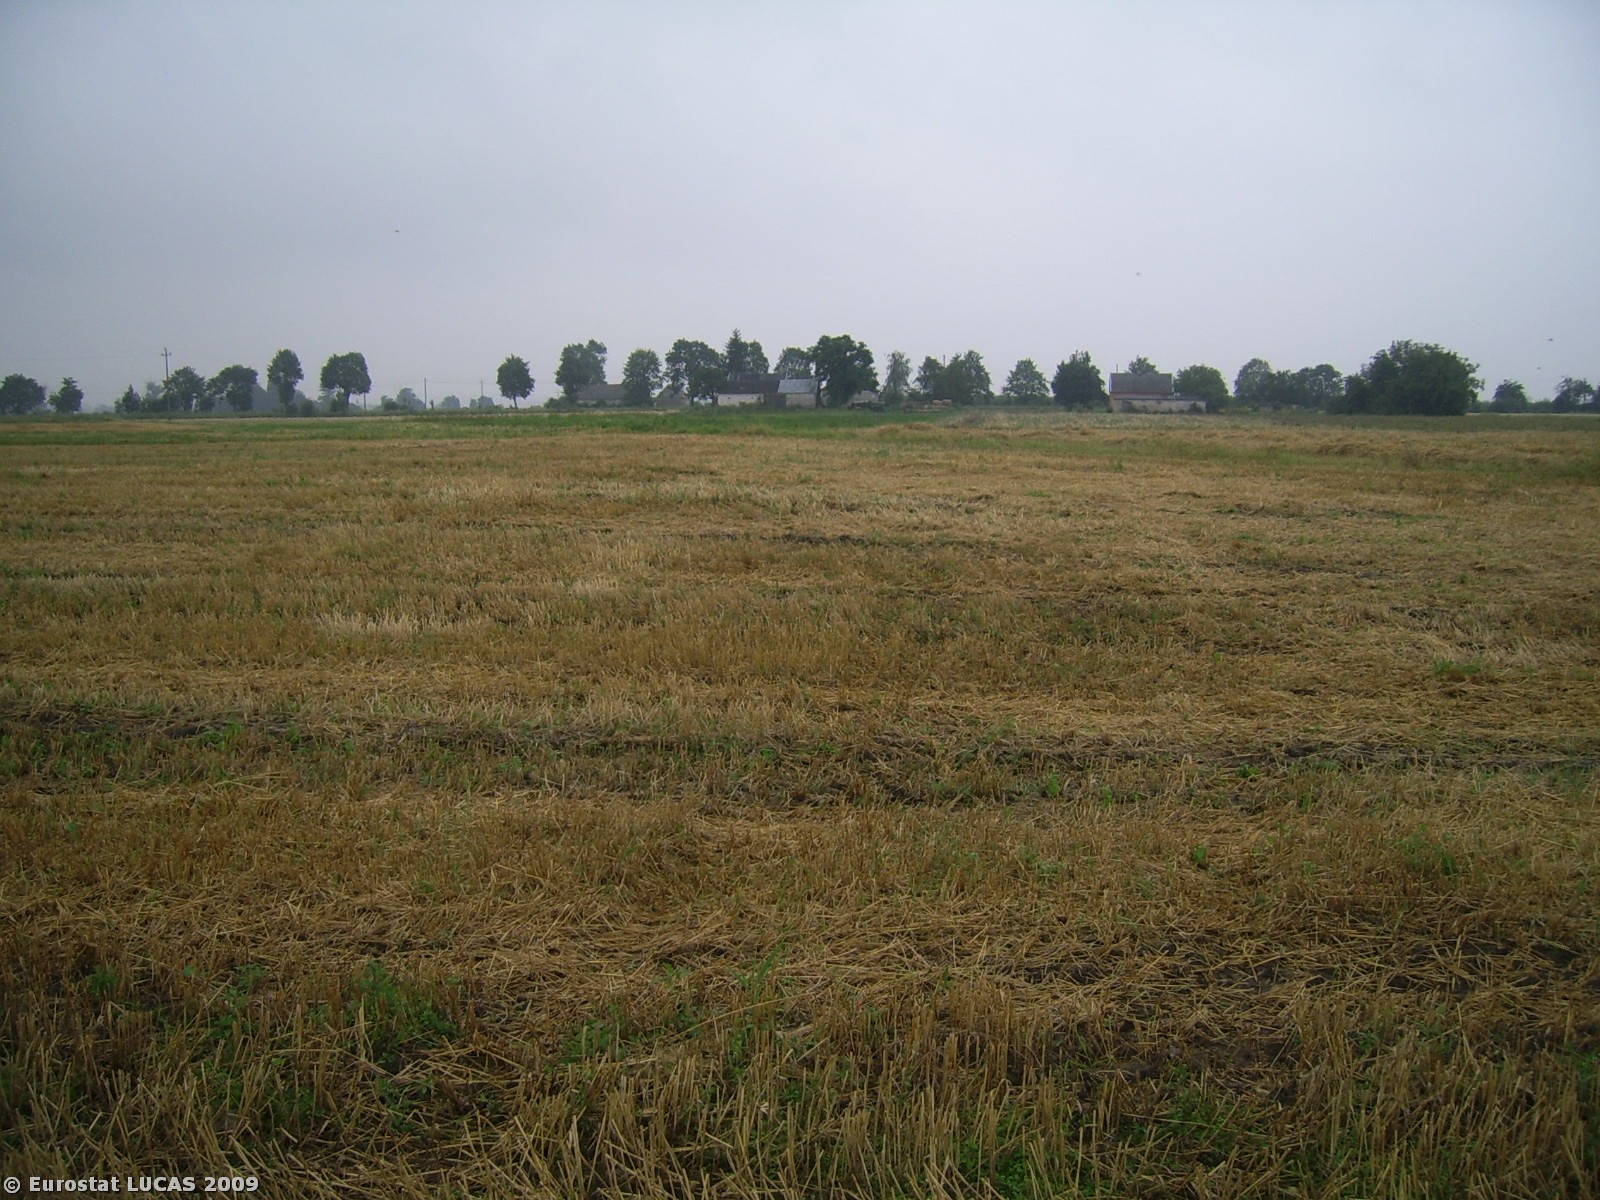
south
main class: Cropland
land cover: Common wheat
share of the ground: < 10 %
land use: Agriculture (excluding fallow land and kitchen gardens)
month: August
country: PL
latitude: 52.6210
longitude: 18.6615
